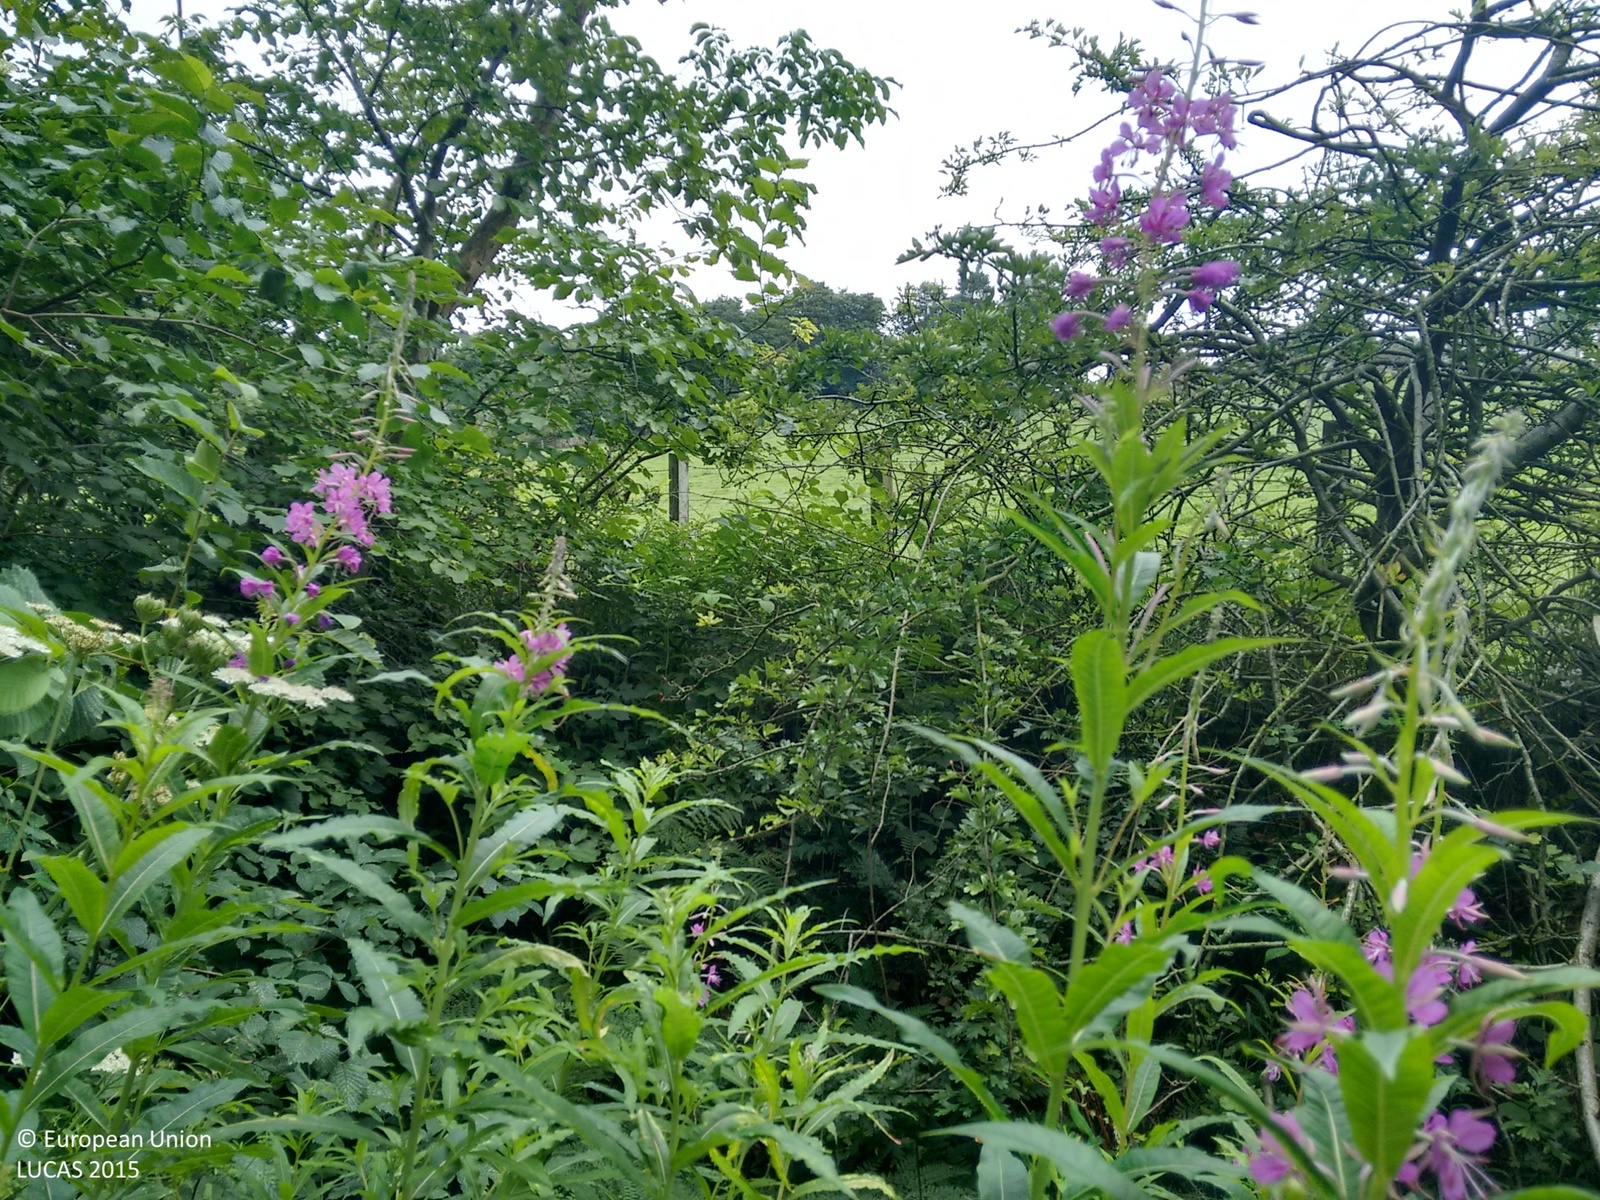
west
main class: Grassland
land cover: Grassland without tree/shrub cover
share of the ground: > 75 %
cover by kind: herbaceous plants 100 %
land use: Agriculture (excluding fallow land and kitchen gardens)
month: August
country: GB
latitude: 56.2320
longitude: -3.0210
